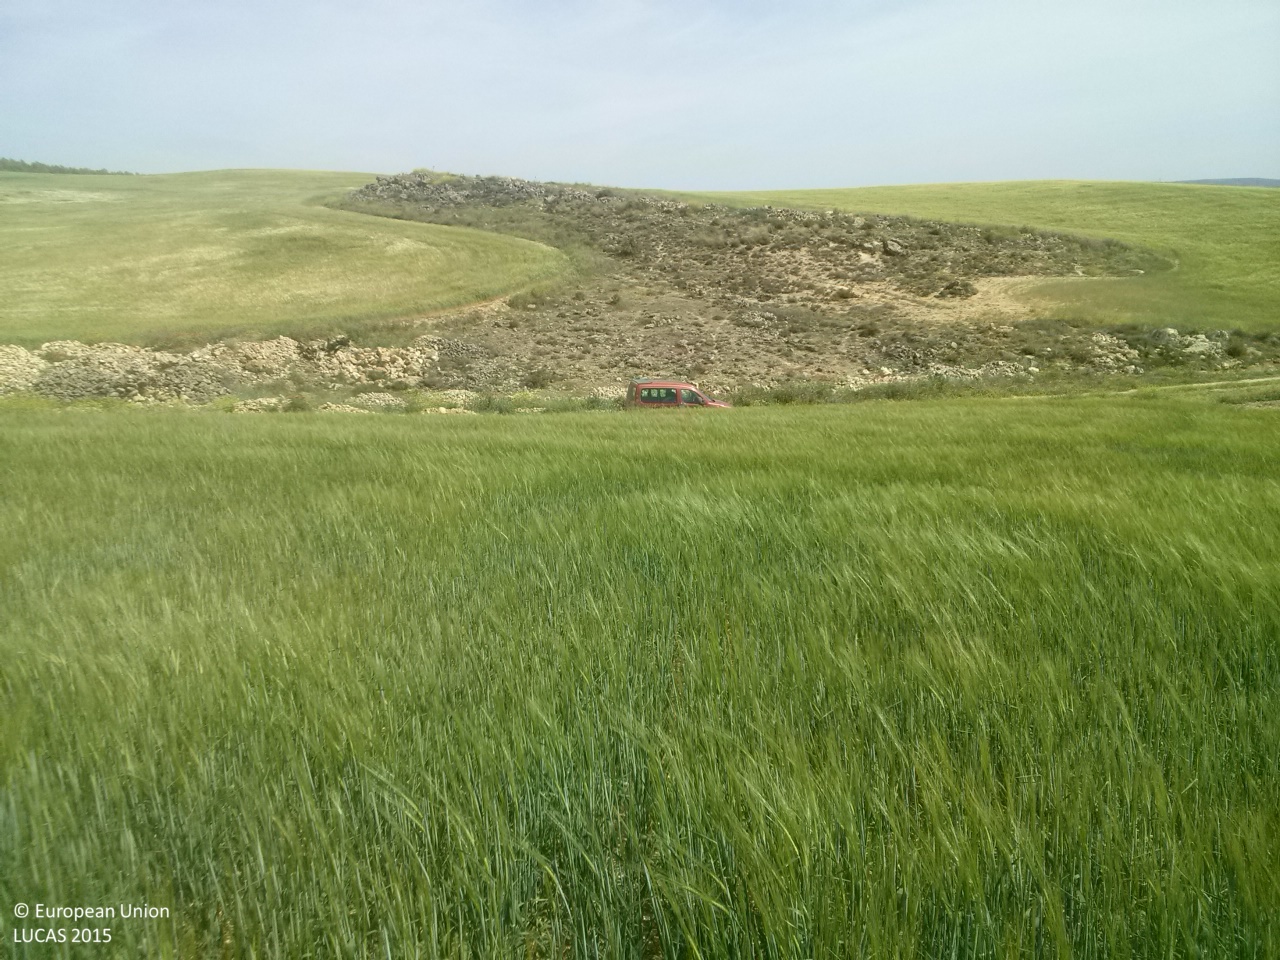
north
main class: Cropland
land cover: Barley
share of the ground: > 75 %
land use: Agriculture (excluding fallow land and kitchen gardens)
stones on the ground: 25 - 50 %
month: May
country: ES
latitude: 39.7758
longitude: -2.6378
